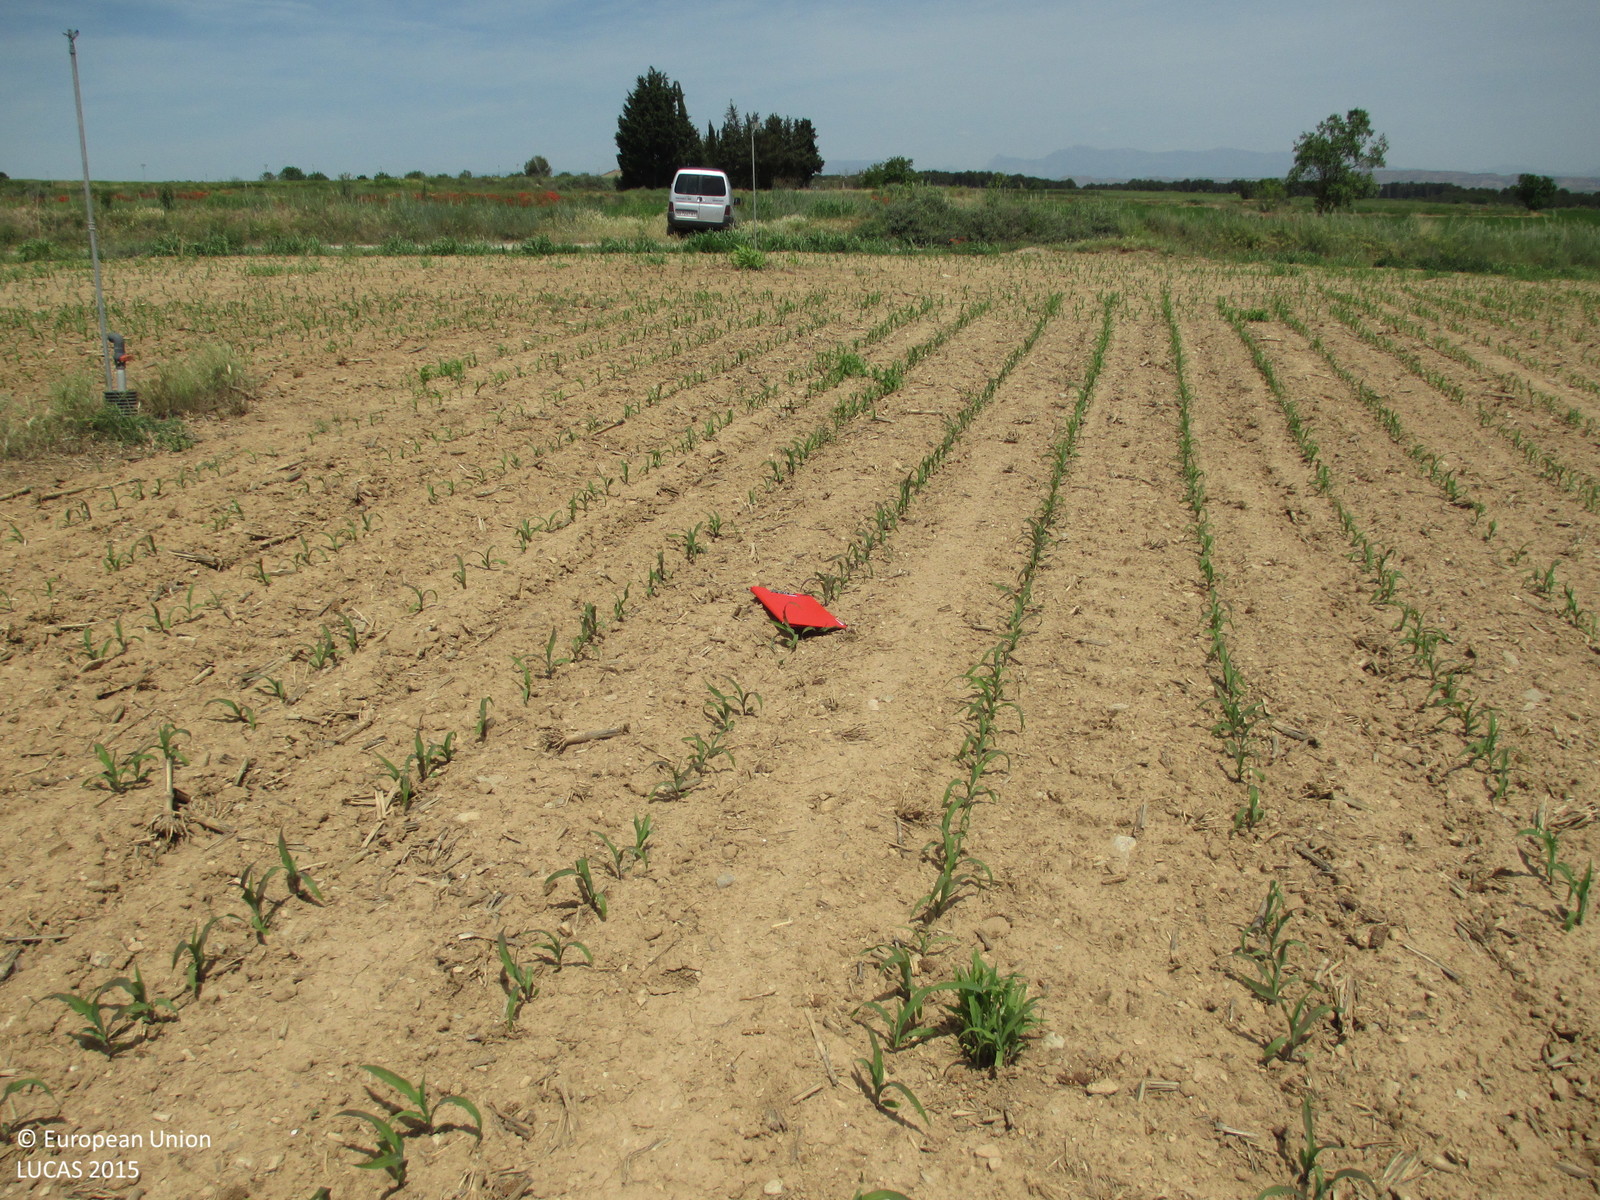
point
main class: Cropland
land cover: Maize
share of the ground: < 10 %
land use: Agriculture (excluding fallow land and kitchen gardens)
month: May
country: ES
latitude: 41.8682
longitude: -0.3449
